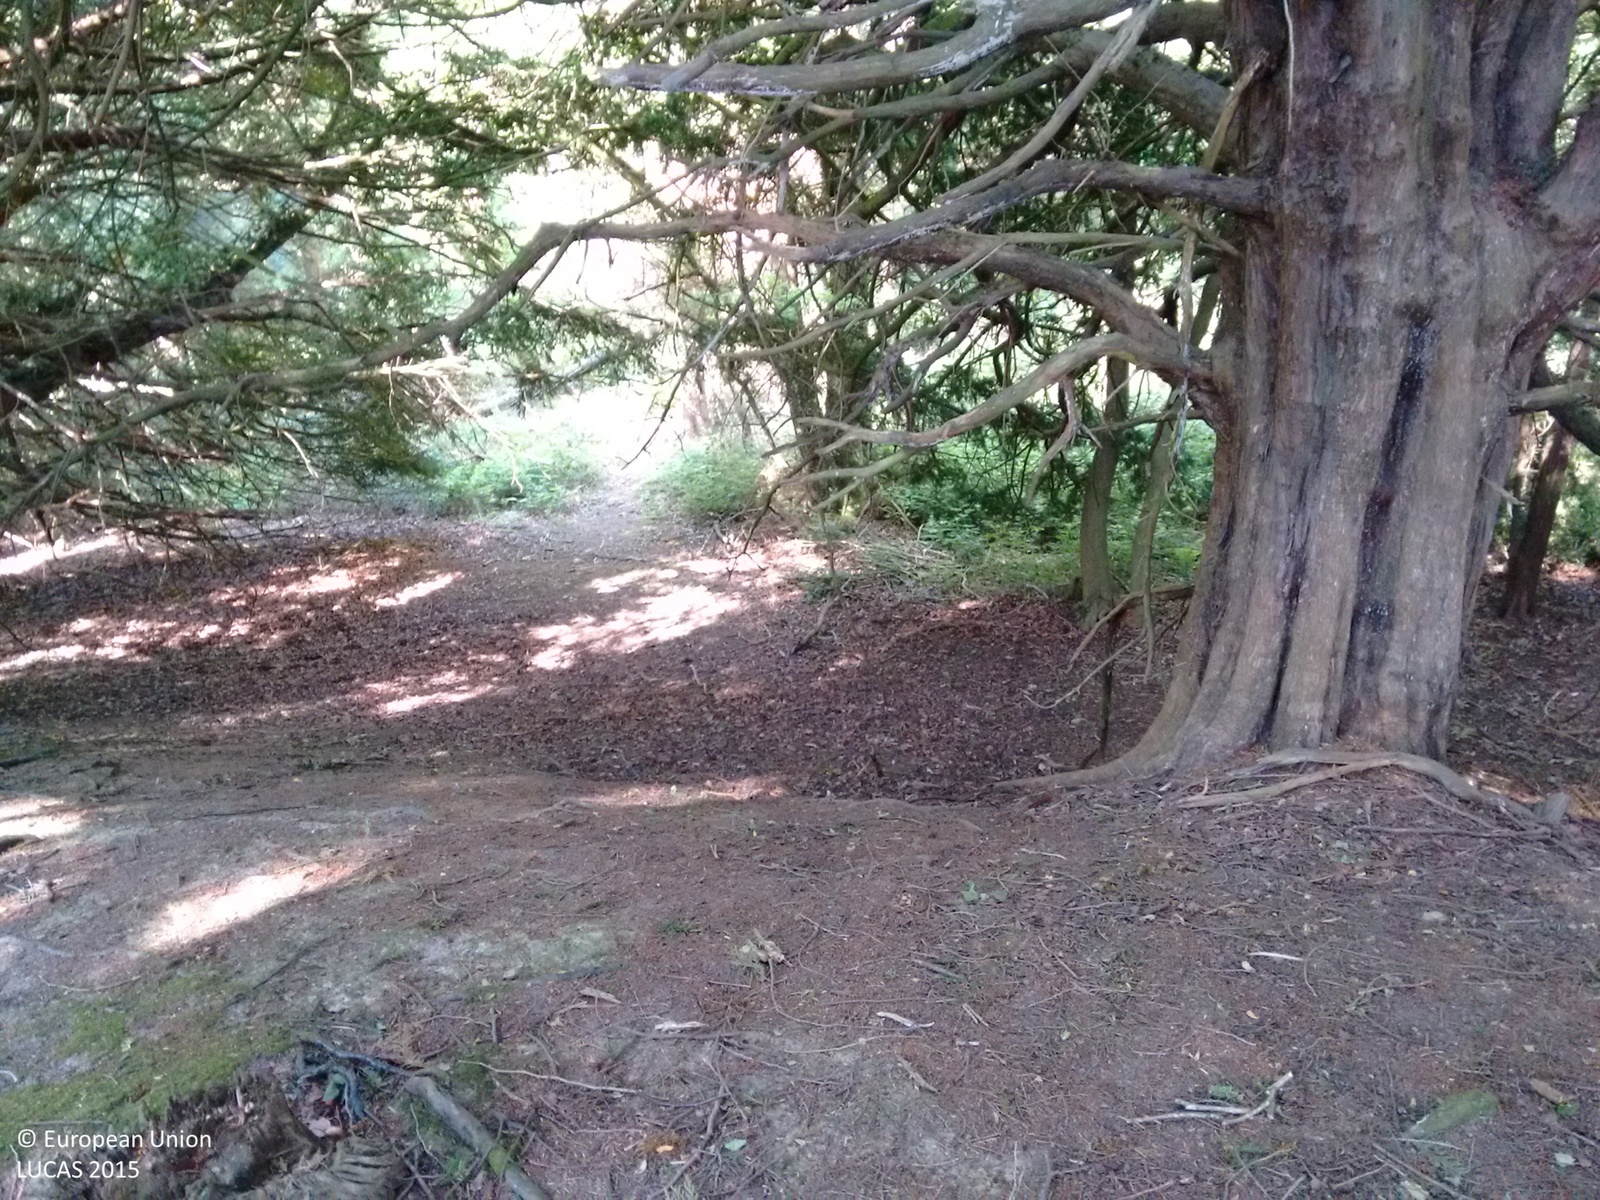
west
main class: Woodland
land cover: Other coniferous woodland
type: hemiboreal forest and nemoral coniferous forest and mixed broadleaved-coniferous forest
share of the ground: > 75 %
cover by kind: coniferous forest trees 100 %
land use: Forestry
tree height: > 5 m
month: June
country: GB
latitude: 52.0324
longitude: -2.4112
